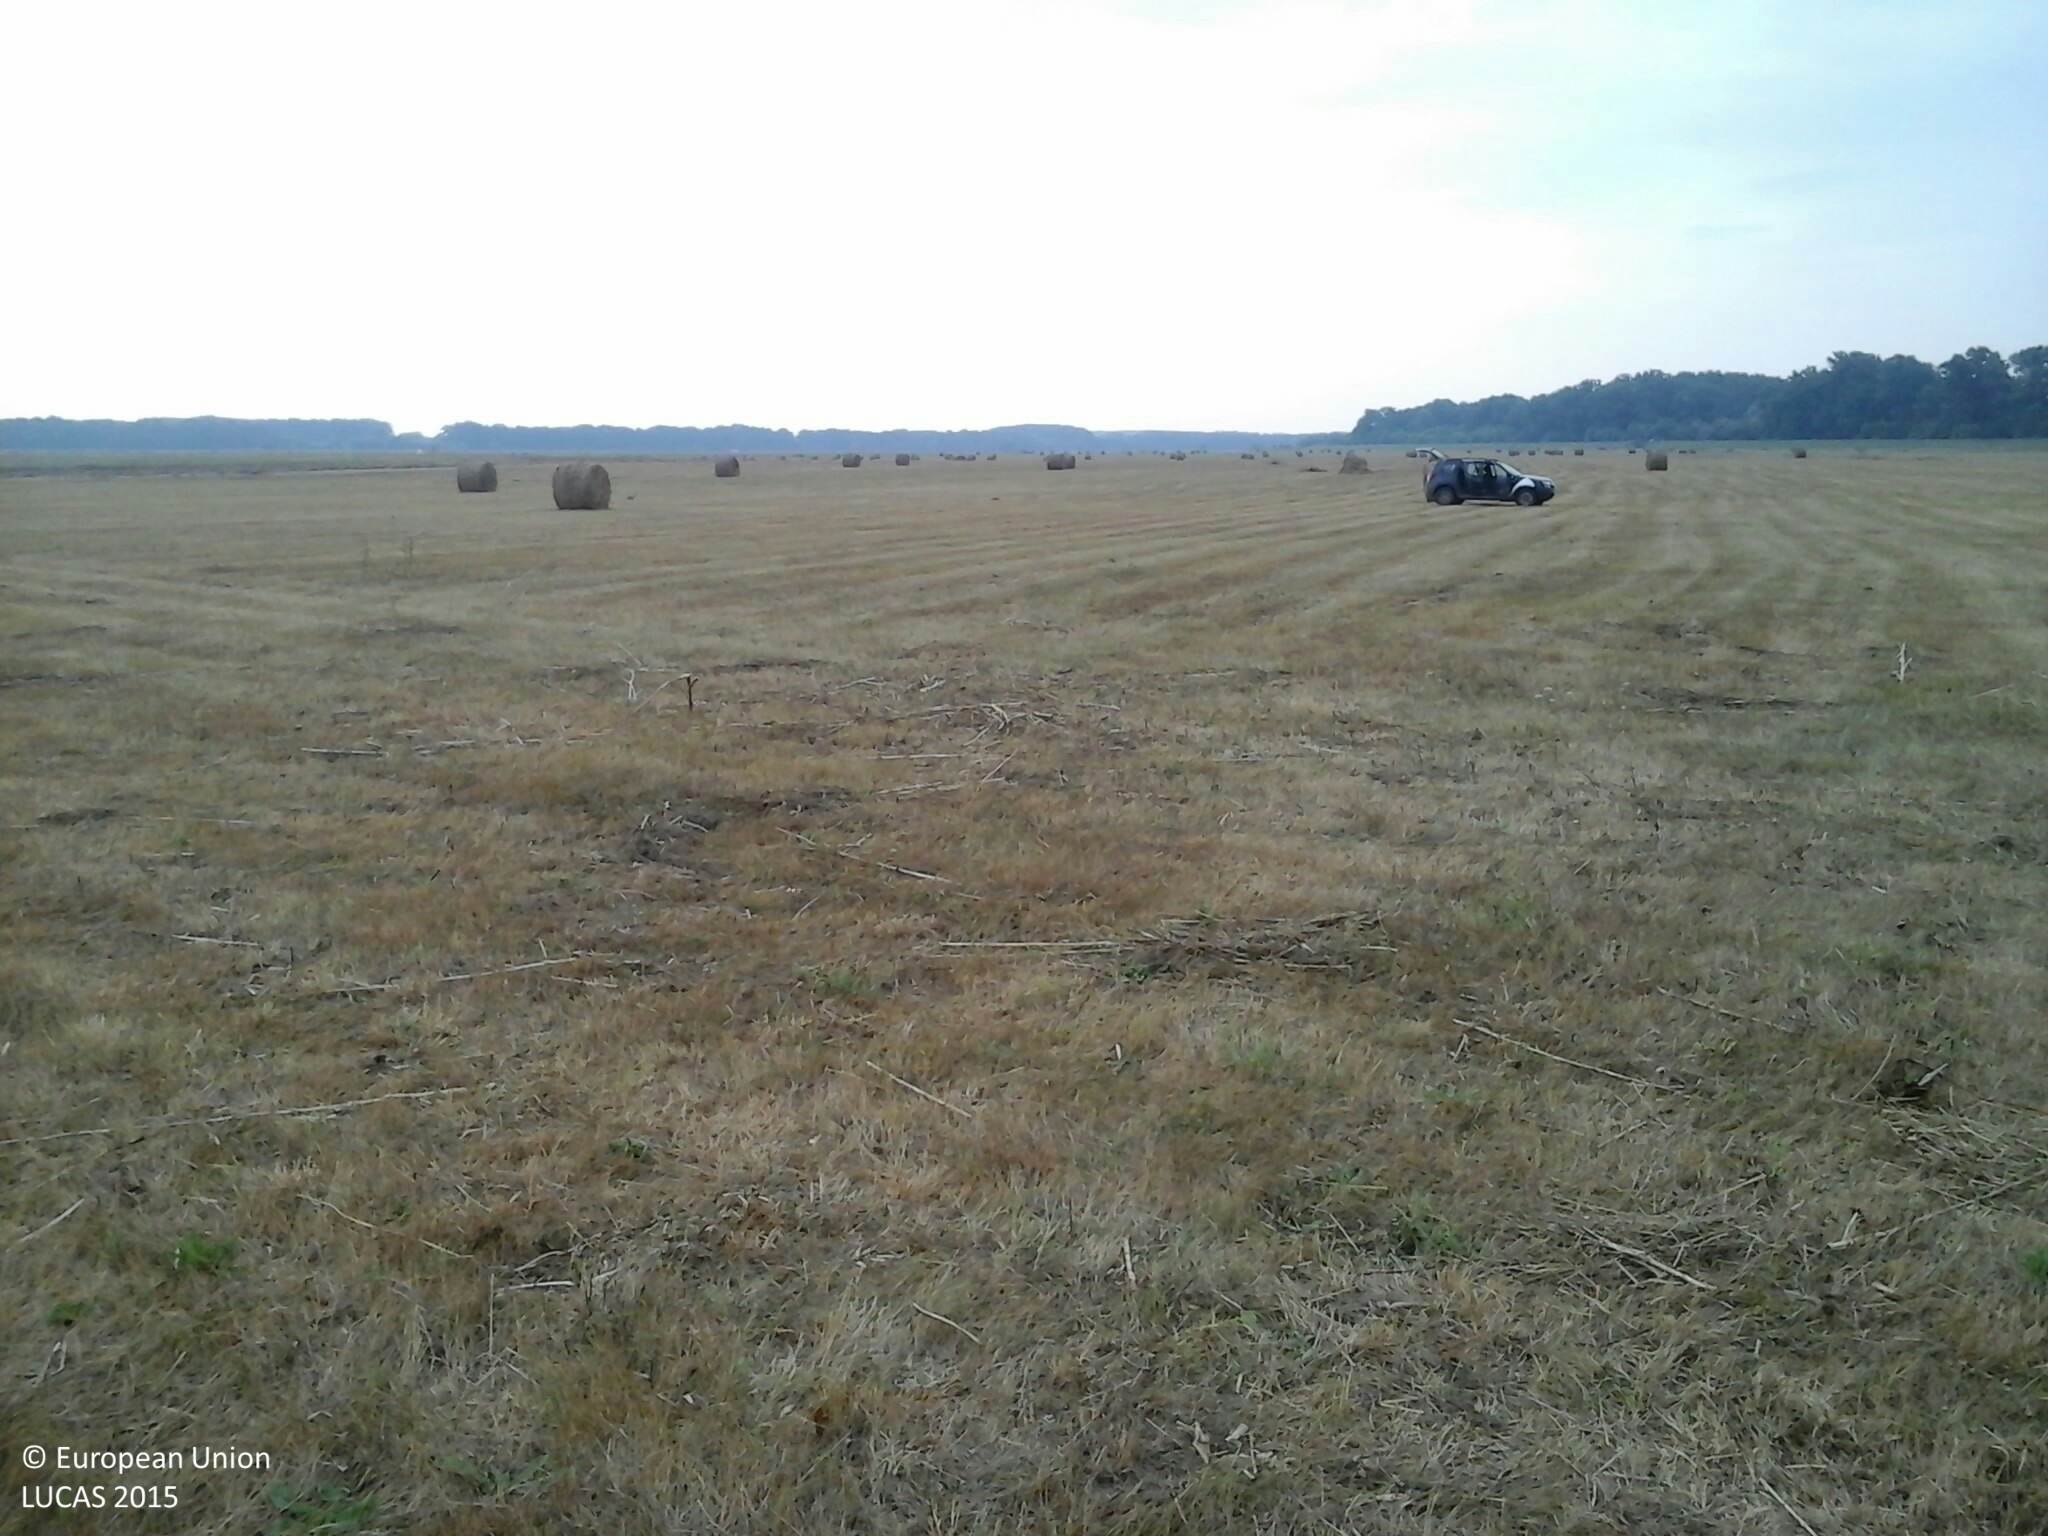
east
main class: Grassland
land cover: Grassland without tree/shrub cover
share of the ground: > 75 %
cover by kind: herbaceous plants 100 %
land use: Agriculture (excluding fallow land and kitchen gardens)
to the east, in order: Grassland without tree/shrub cover; Tracks; Grassland without tree/shrub cover
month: August
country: HU
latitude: 47.9735
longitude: 21.0642
